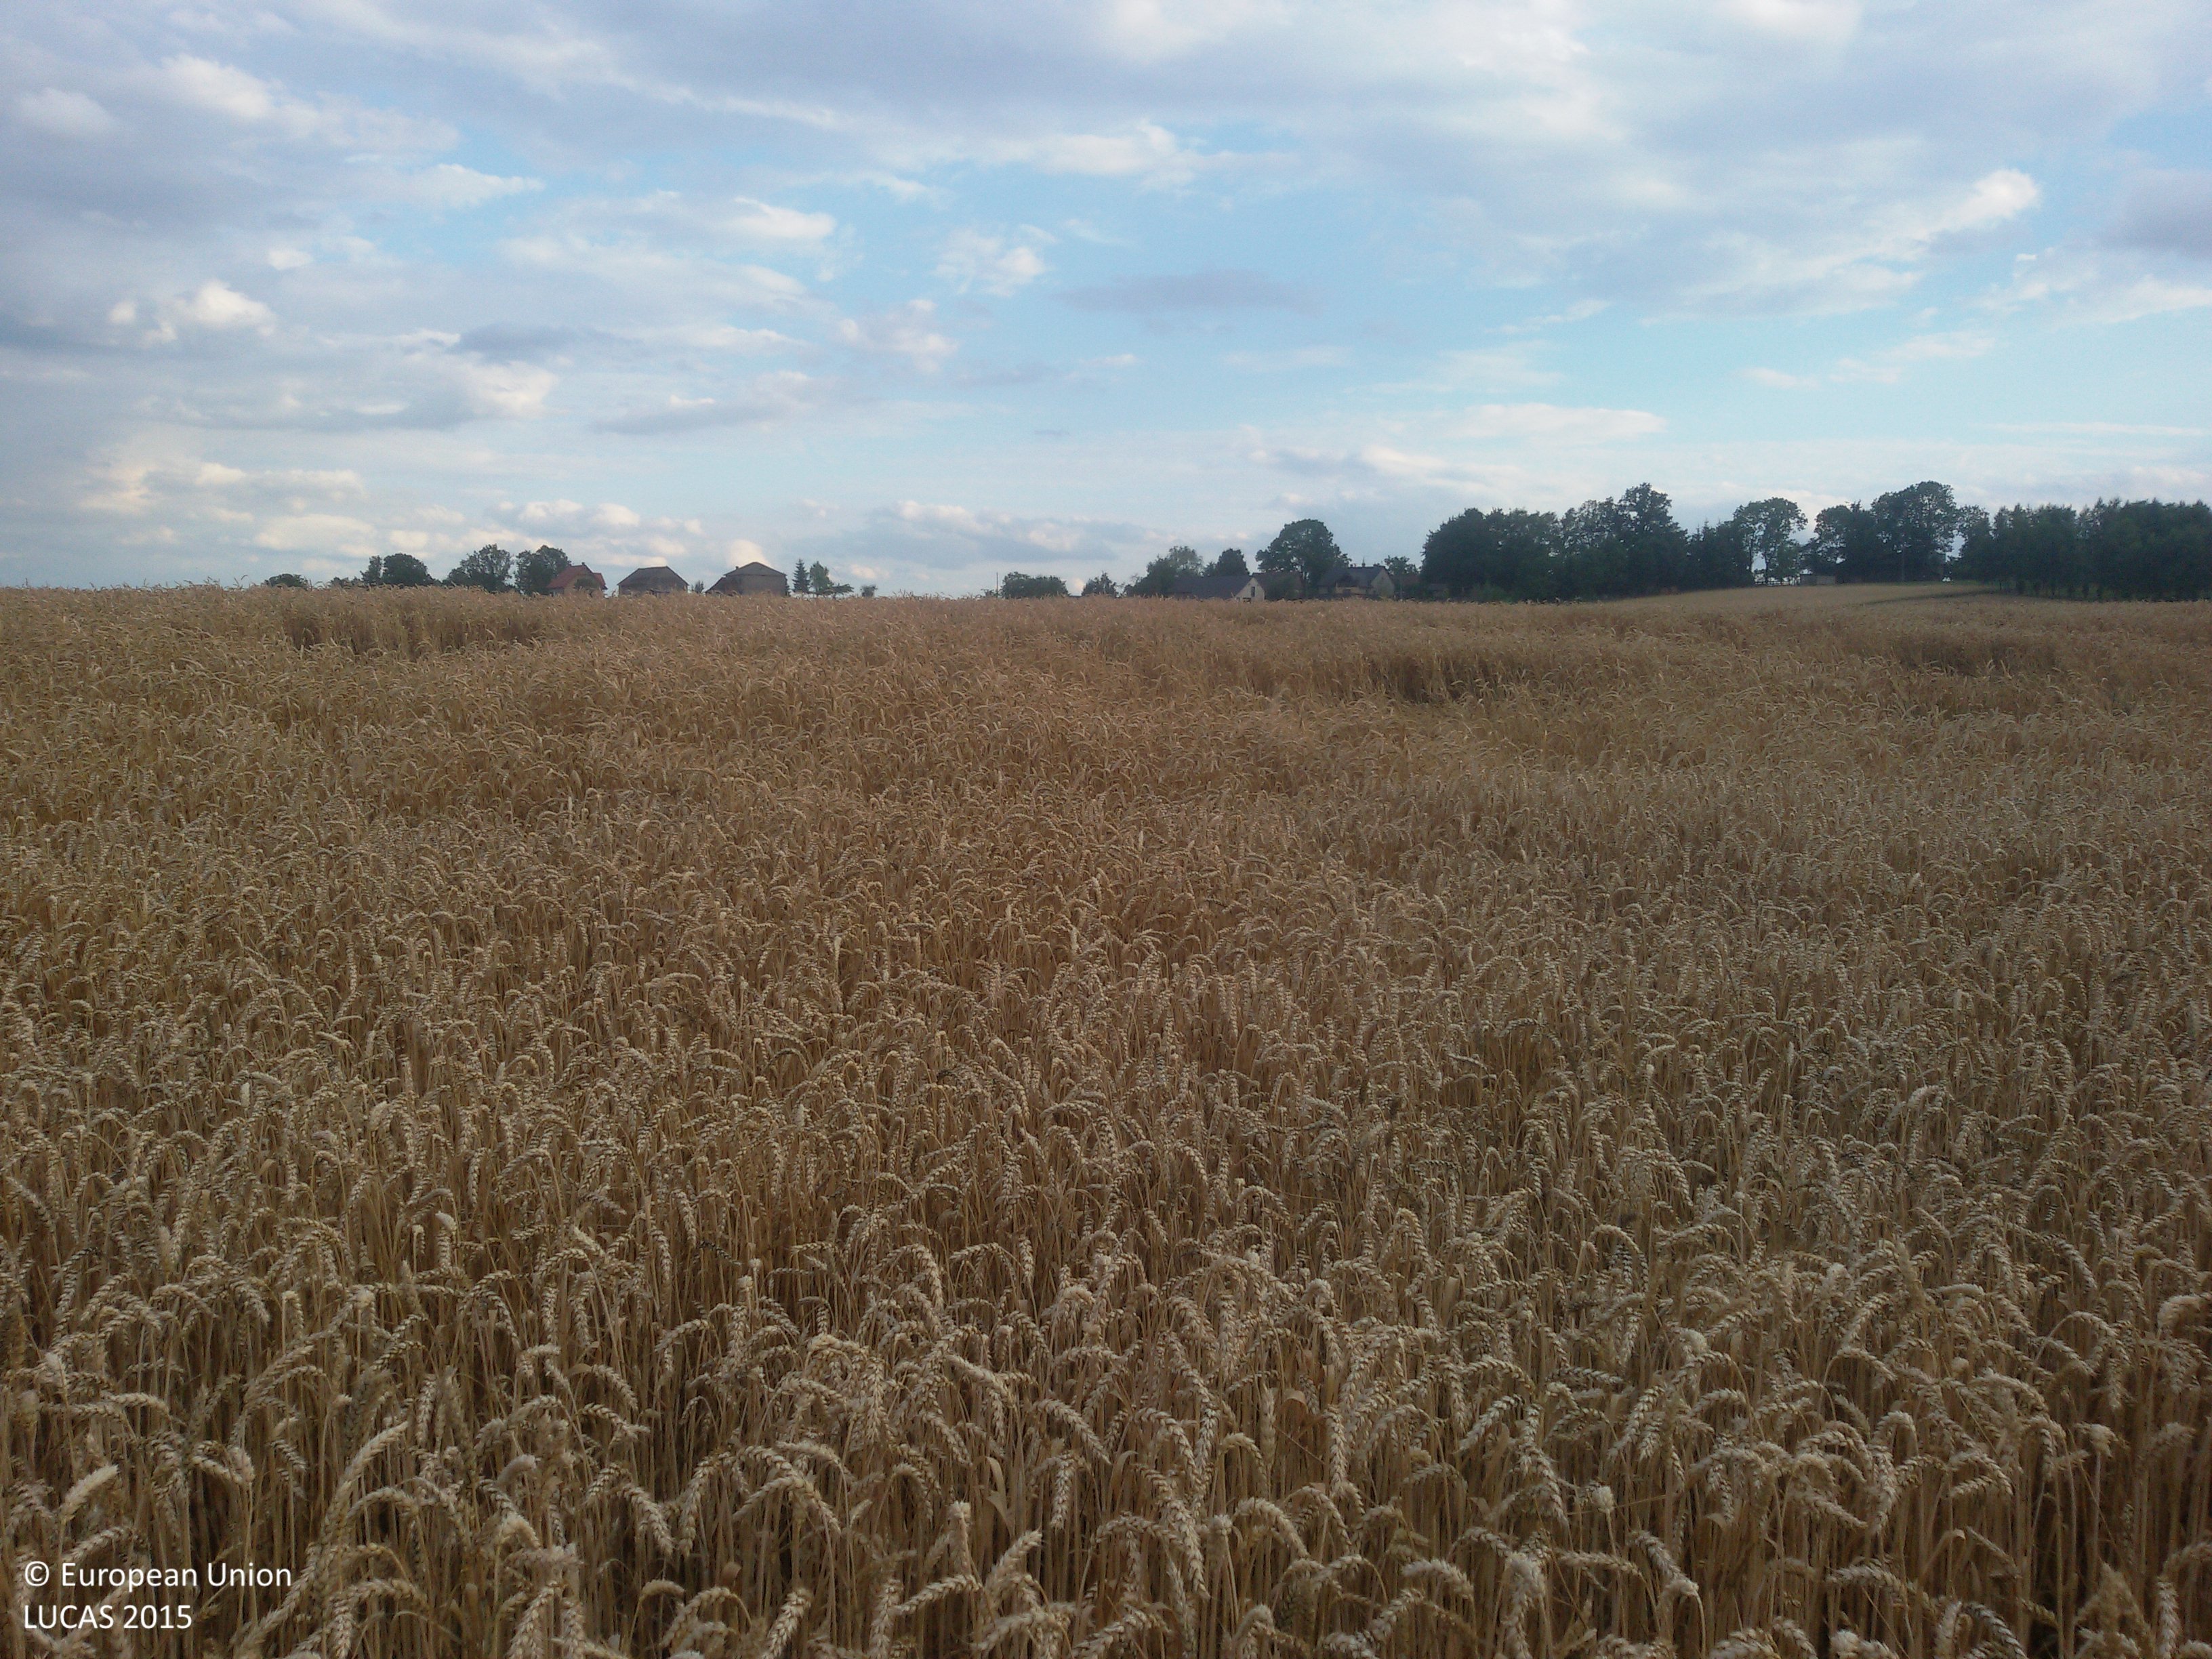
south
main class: Cropland
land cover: Common wheat
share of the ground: > 75 %
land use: Agriculture (excluding fallow land and kitchen gardens)
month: July
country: PL
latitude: 49.9591
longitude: 20.2240
